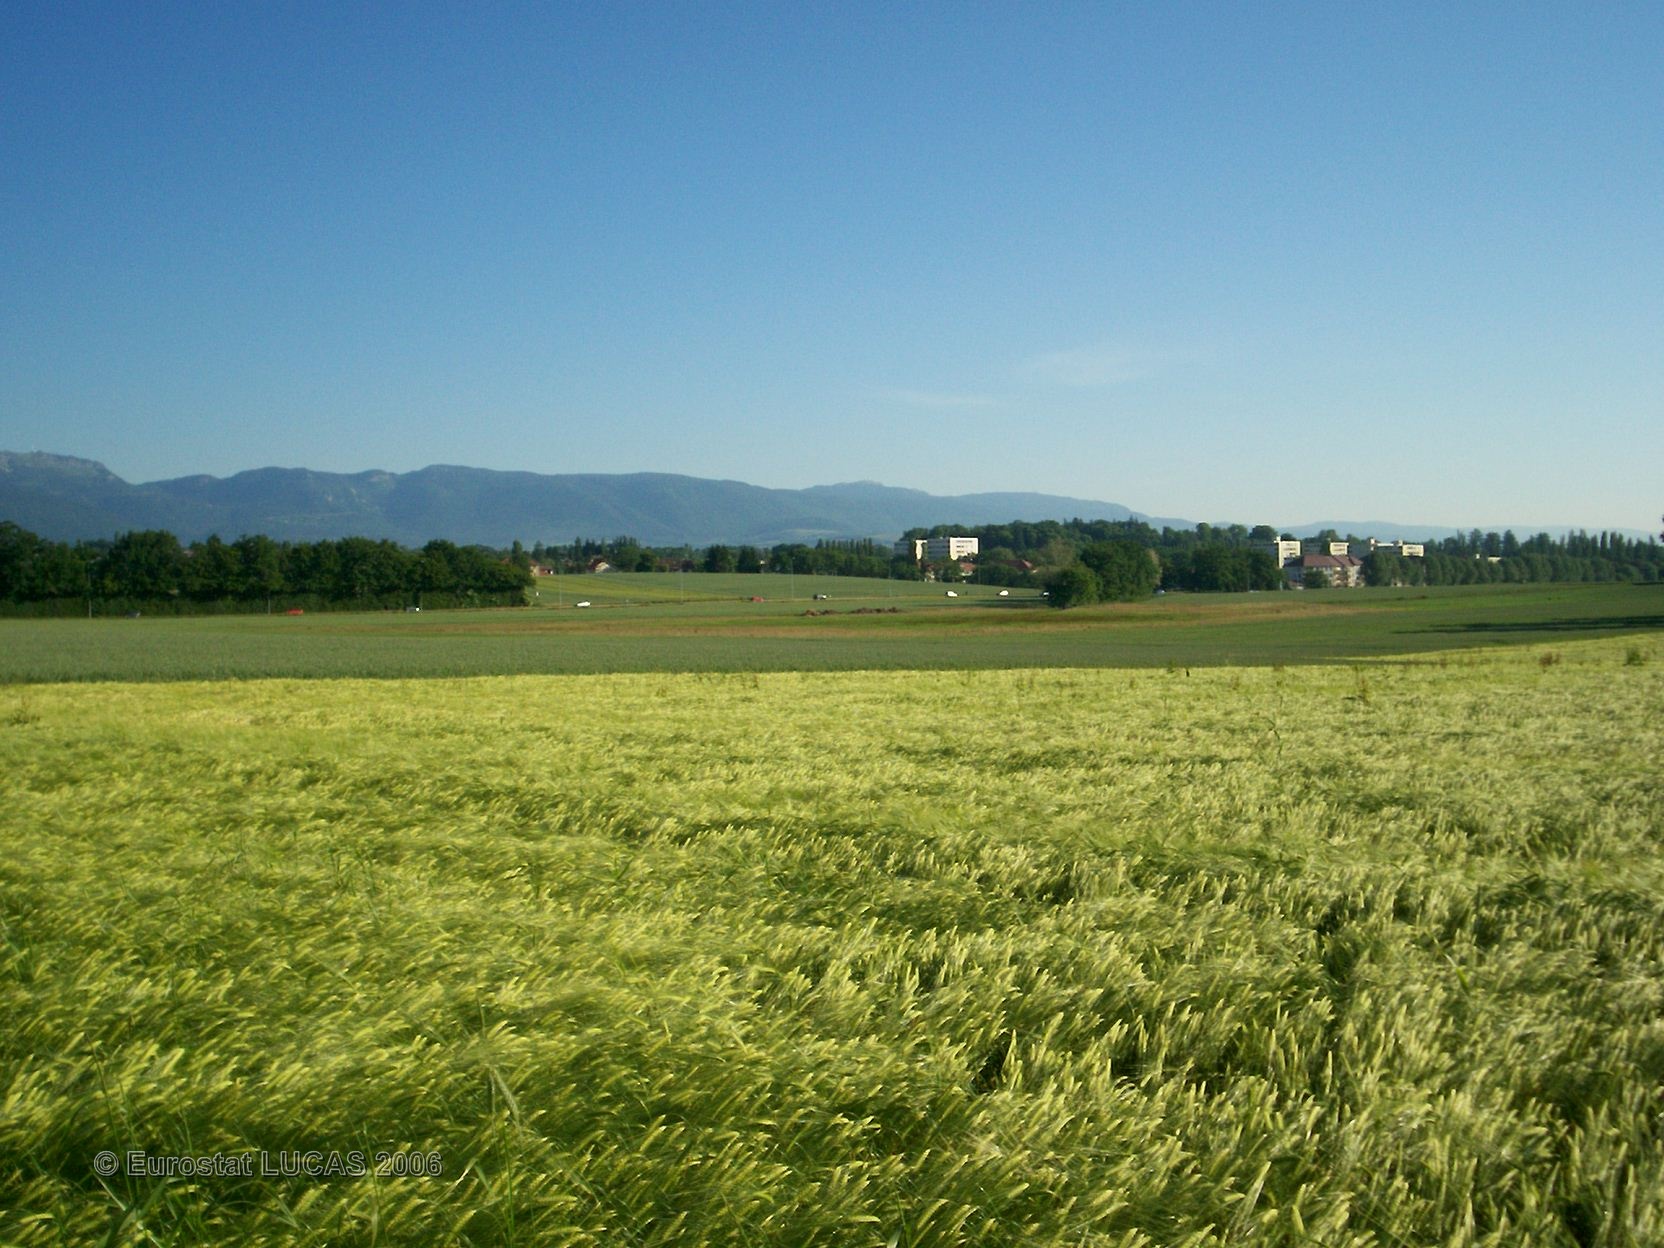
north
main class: Cropland
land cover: Barley
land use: Agriculture (excluding fallow land and kitchen gardens)
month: June
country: FR
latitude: 46.2441
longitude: 6.0995
